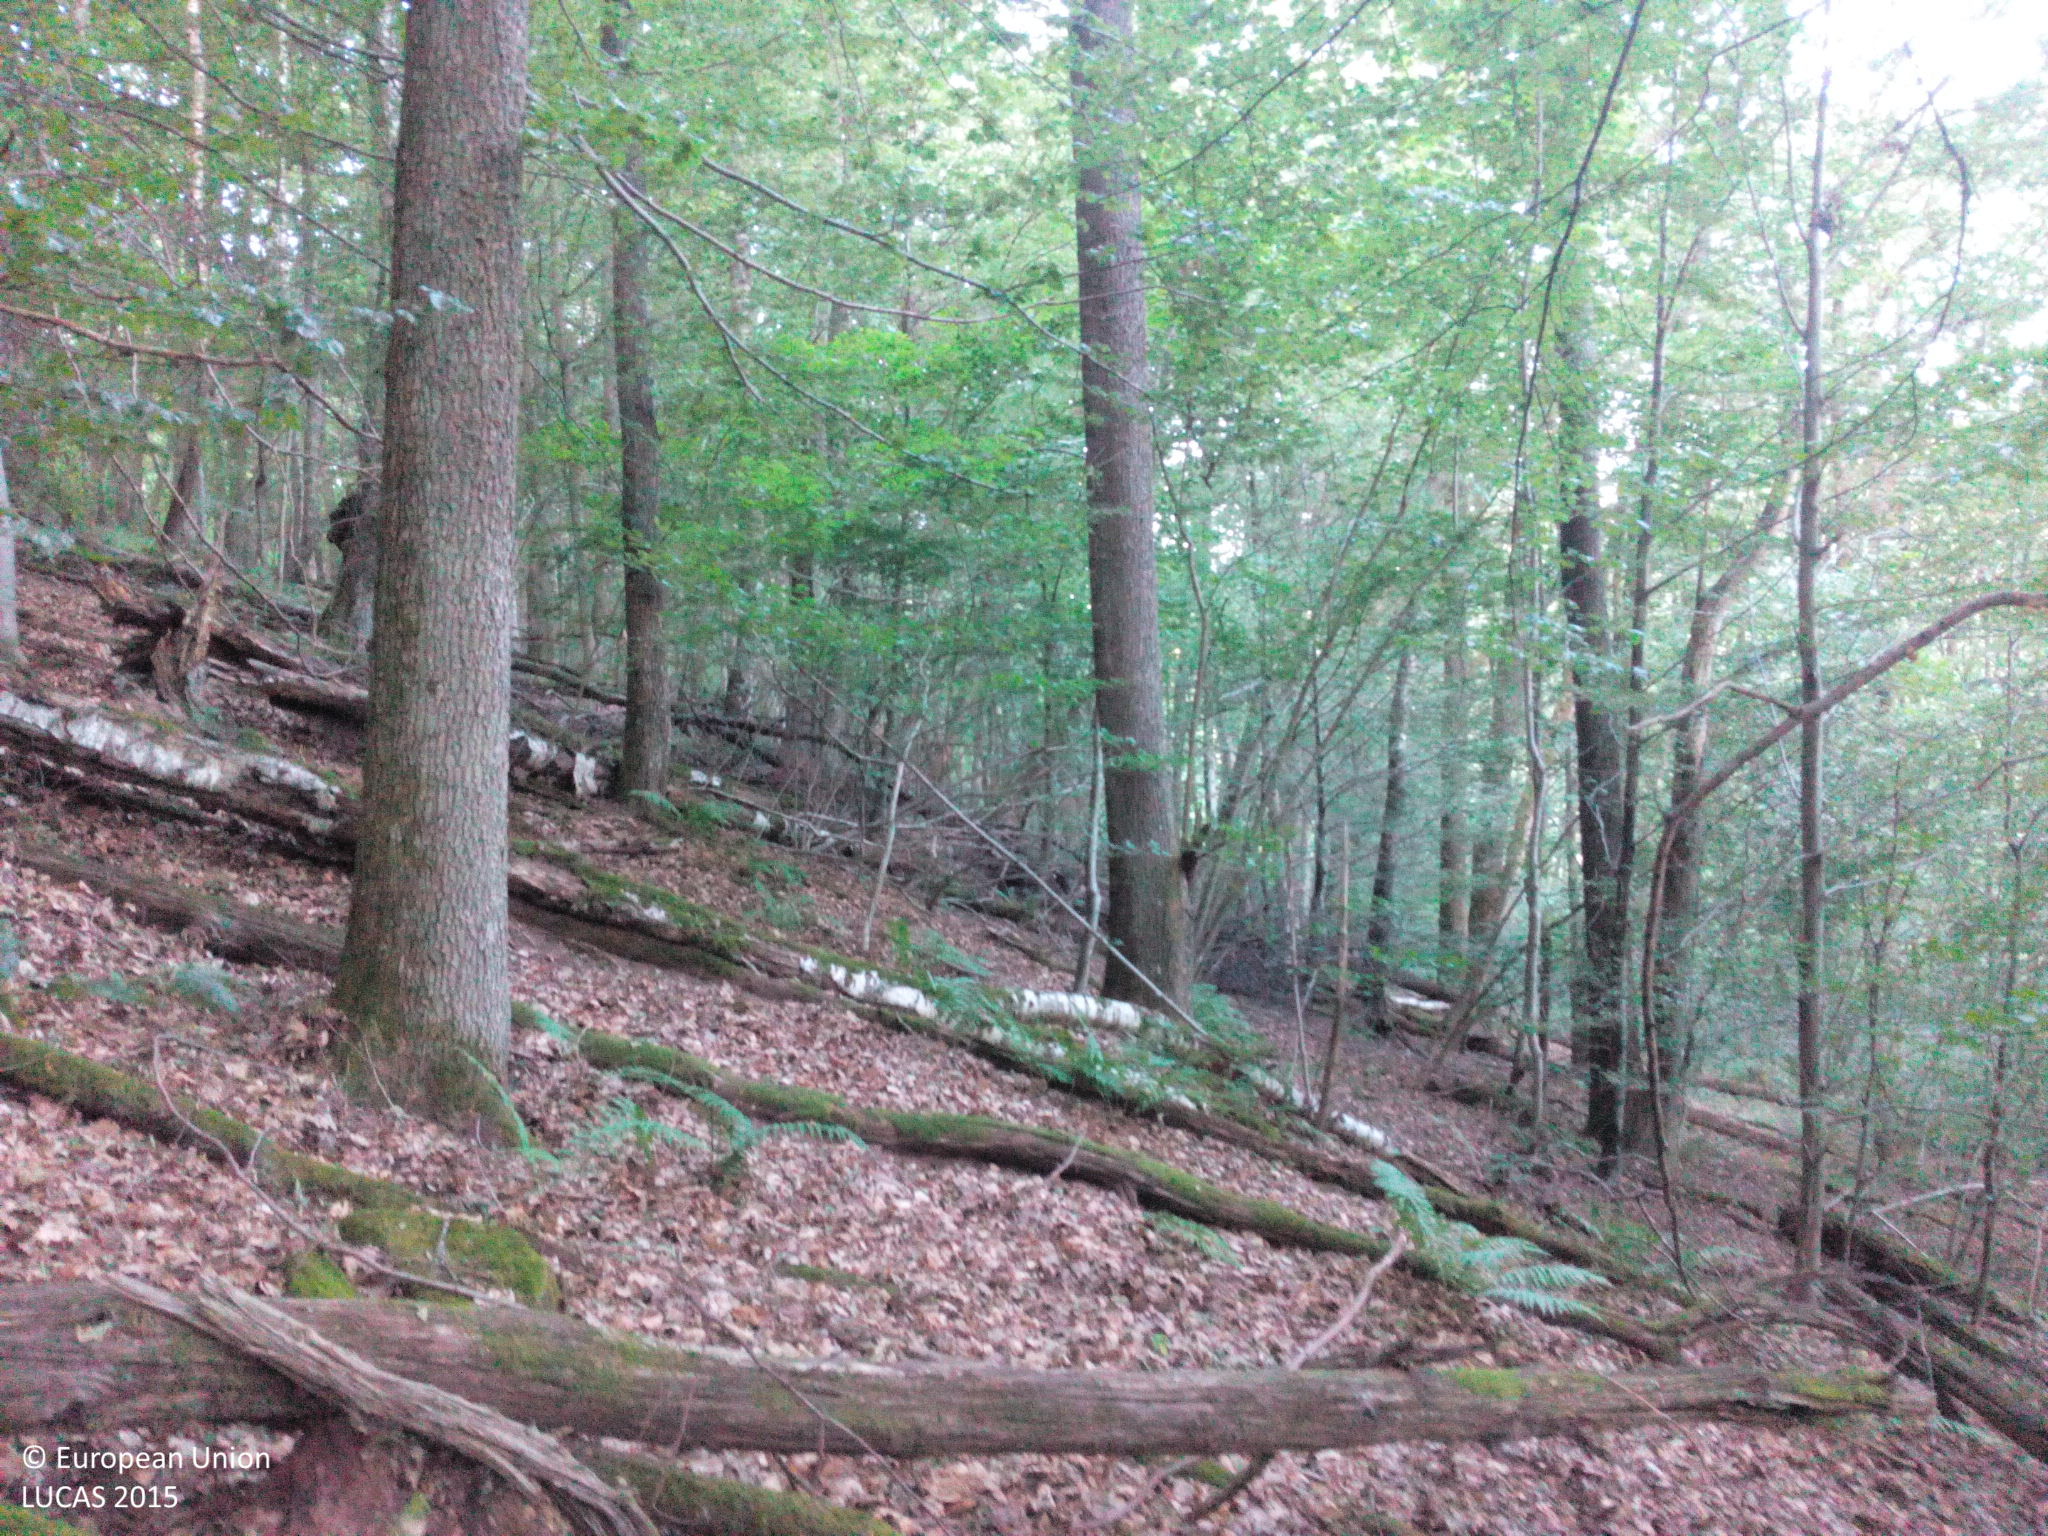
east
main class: Woodland
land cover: Broadleaved woodland
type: beech forest
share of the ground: > 75 %
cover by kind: broadleaved forest trees 90 %, unconsolidated bare surface 10 %
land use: Abandoned areas
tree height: > 5 m
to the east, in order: Broadleaved woodland
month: July
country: DE
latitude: 49.1329
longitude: 7.5747
